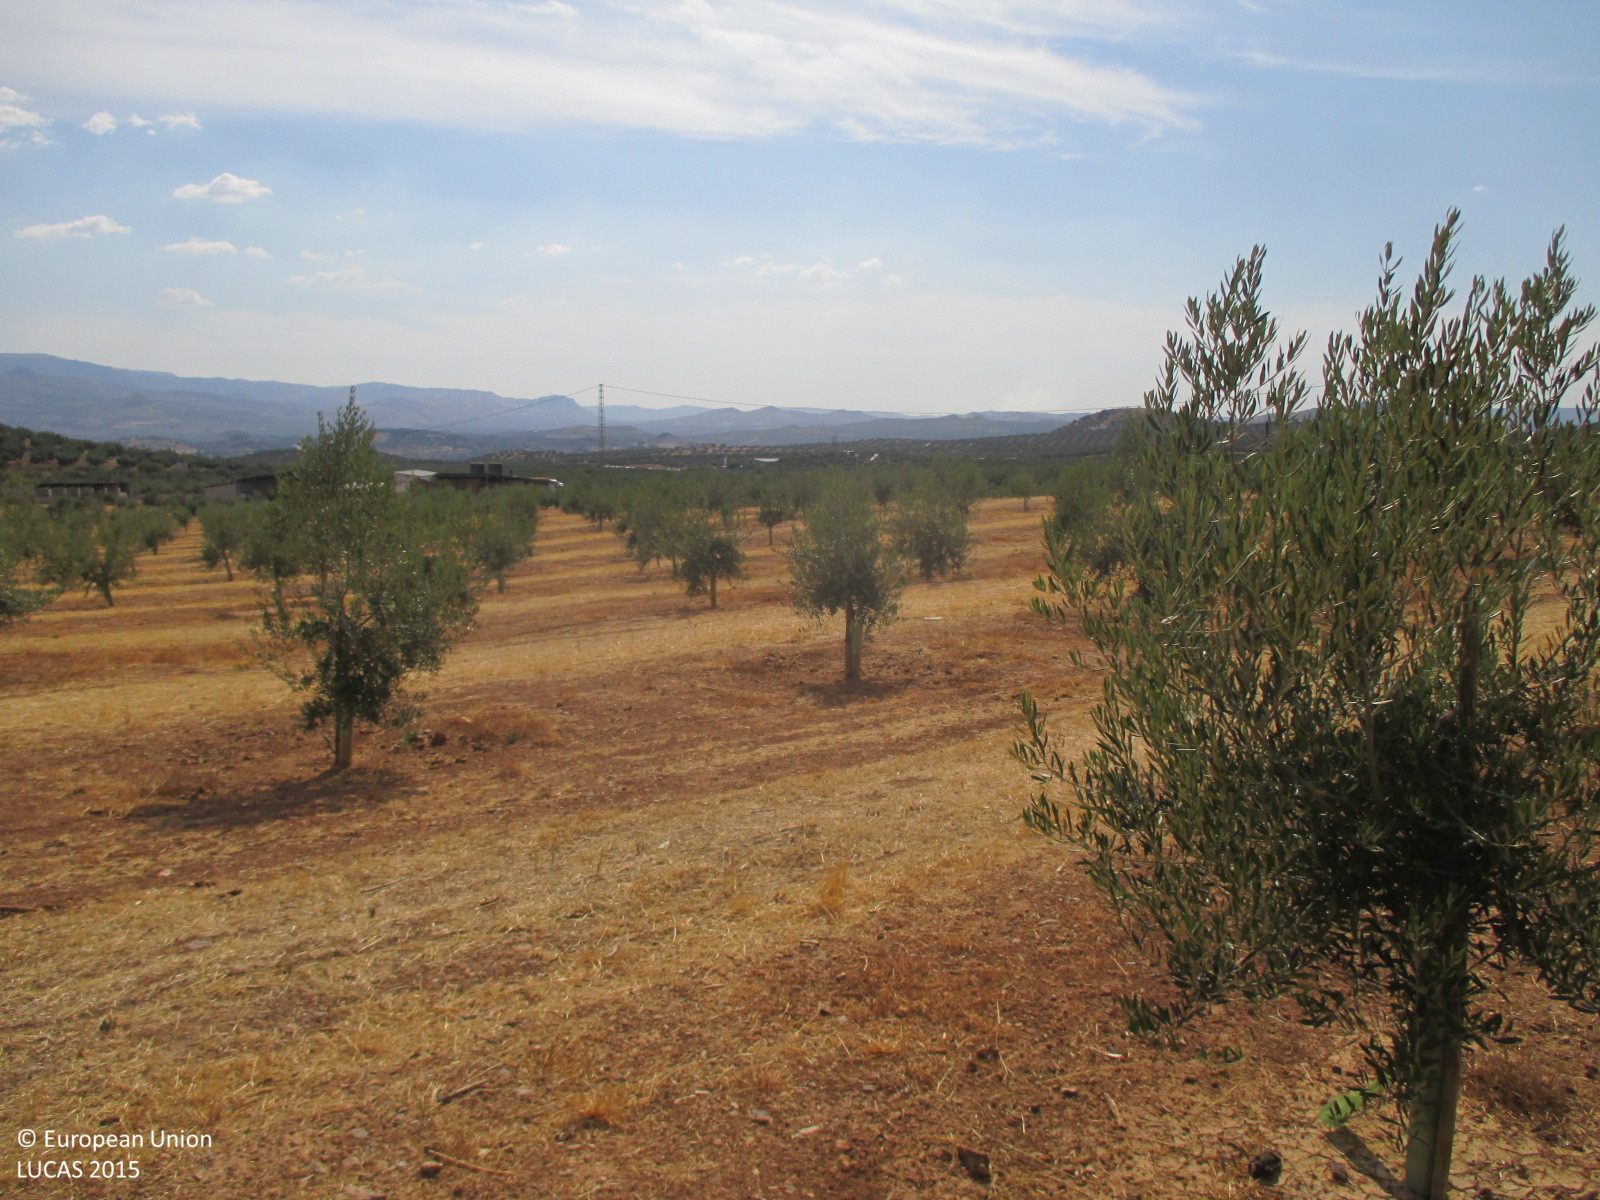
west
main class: Cropland
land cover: Olive groves
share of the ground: < 10 %
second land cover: Spontaneously vegetated surfaces
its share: 10 - 25 %
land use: Agriculture (excluding fallow land and kitchen gardens)
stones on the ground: < 10 %
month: June
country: ES
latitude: 37.5881
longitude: -4.1234
